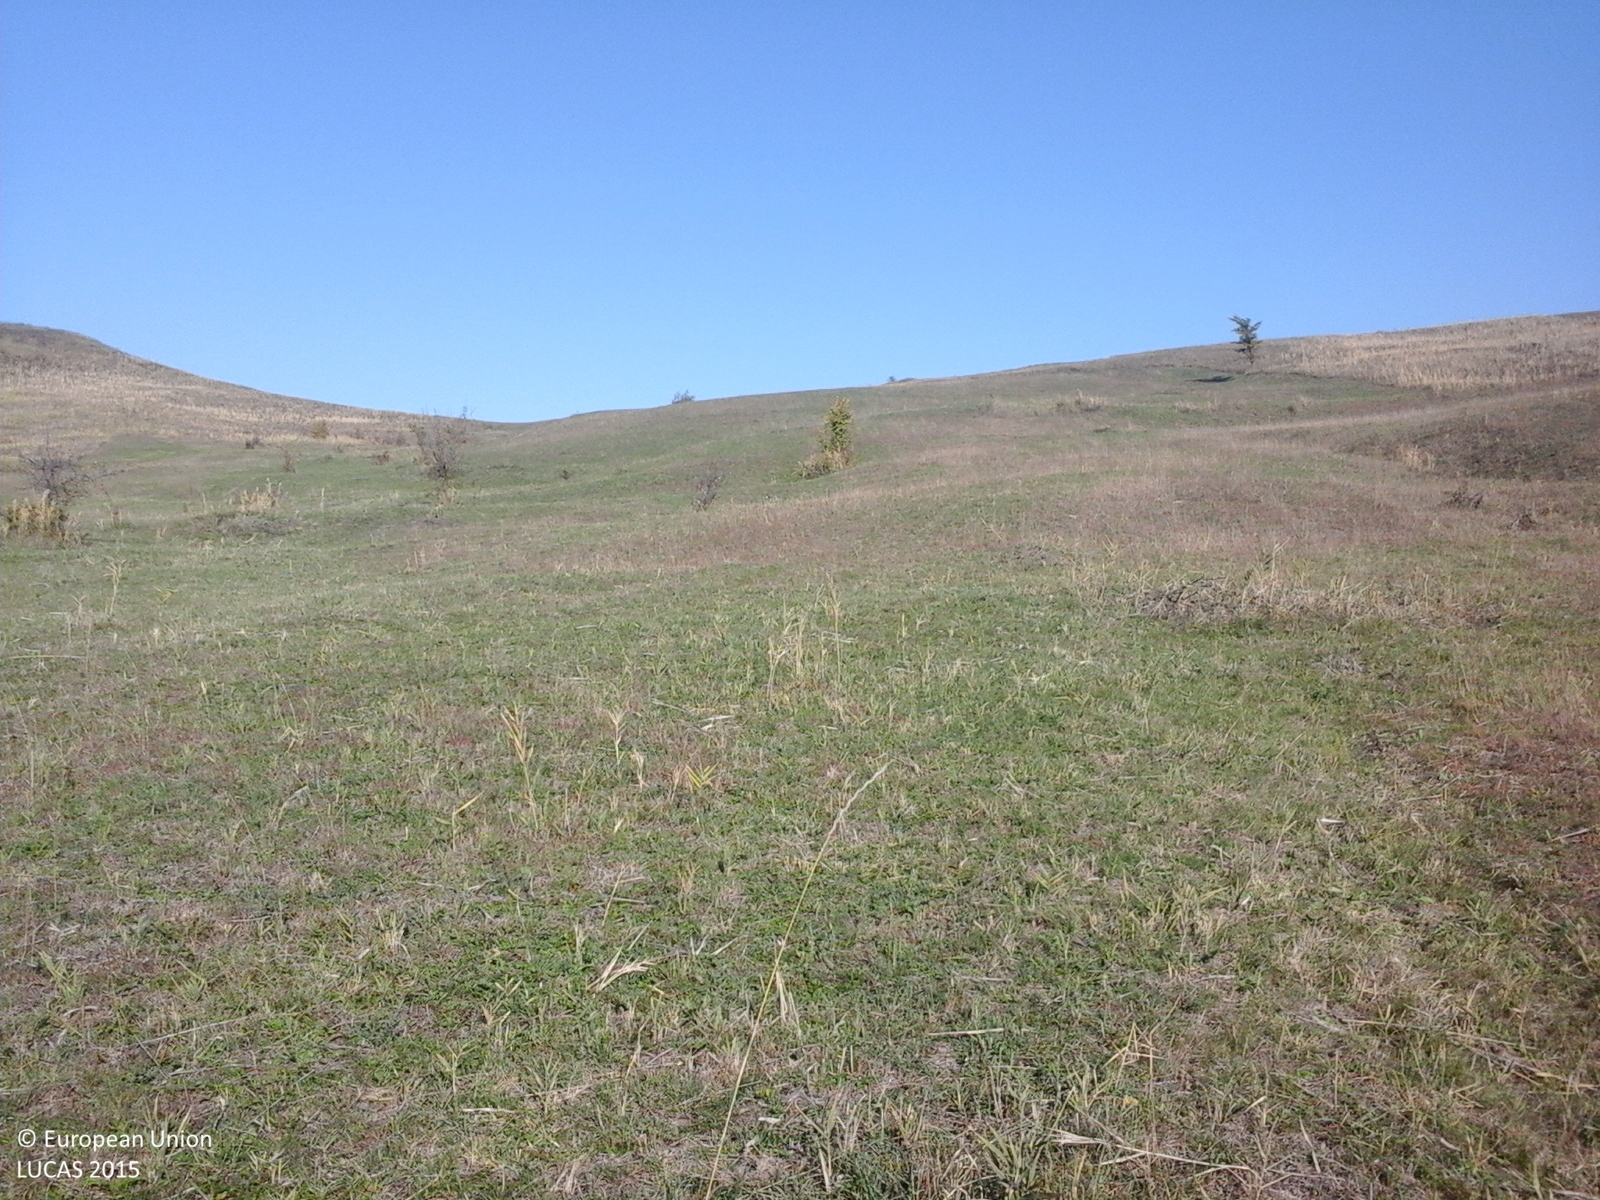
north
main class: Grassland
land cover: Grassland with sparse tree/shrub cover
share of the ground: > 75 %
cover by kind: herbaceous plants 85 %, shrubs 10 %, broadleaved forest trees 5 %
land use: Agriculture (excluding fallow land and kitchen gardens)
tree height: < 5 m
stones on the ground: < 10 %
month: October
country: RO
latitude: 45.3133
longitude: 26.5150
